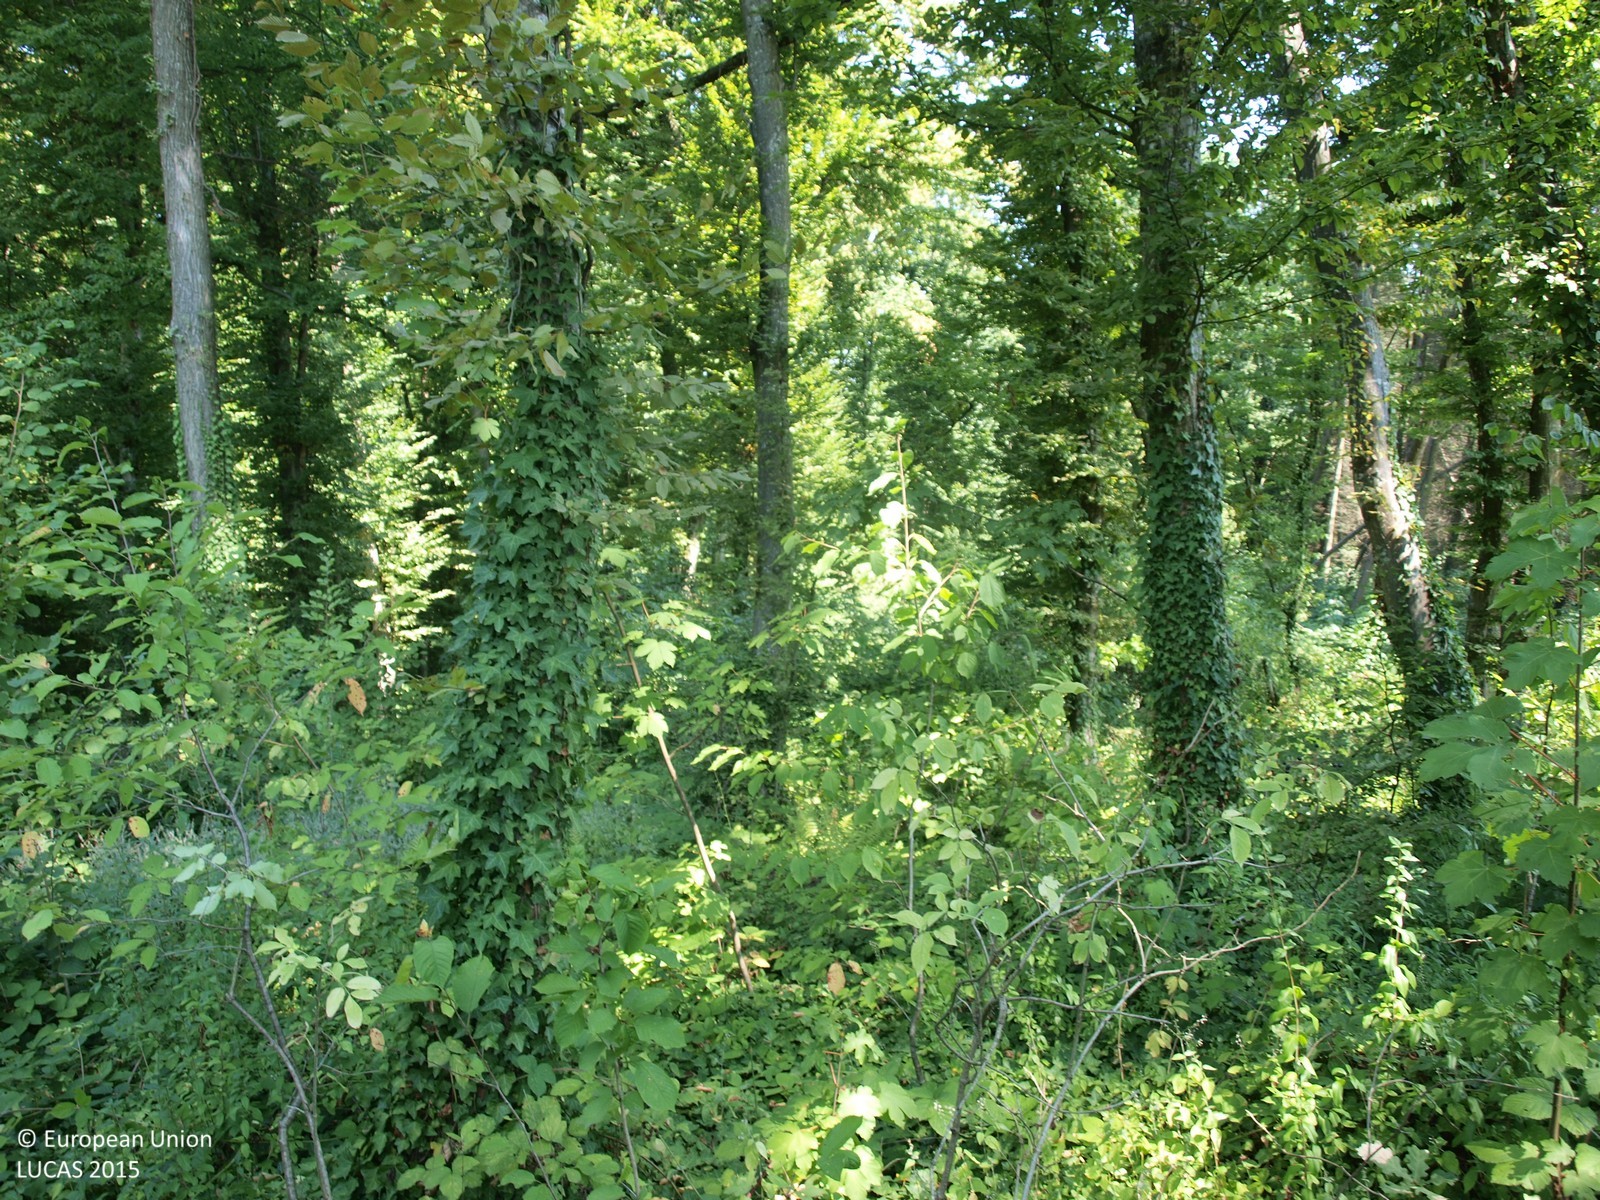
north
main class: Woodland
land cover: Broadleaved woodland
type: mesophytic deciduous forest
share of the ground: > 75 %
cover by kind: broadleaved forest trees 100 %
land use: Forestry
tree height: > 5 m
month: August
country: HR
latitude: 46.0255
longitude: 16.5236
